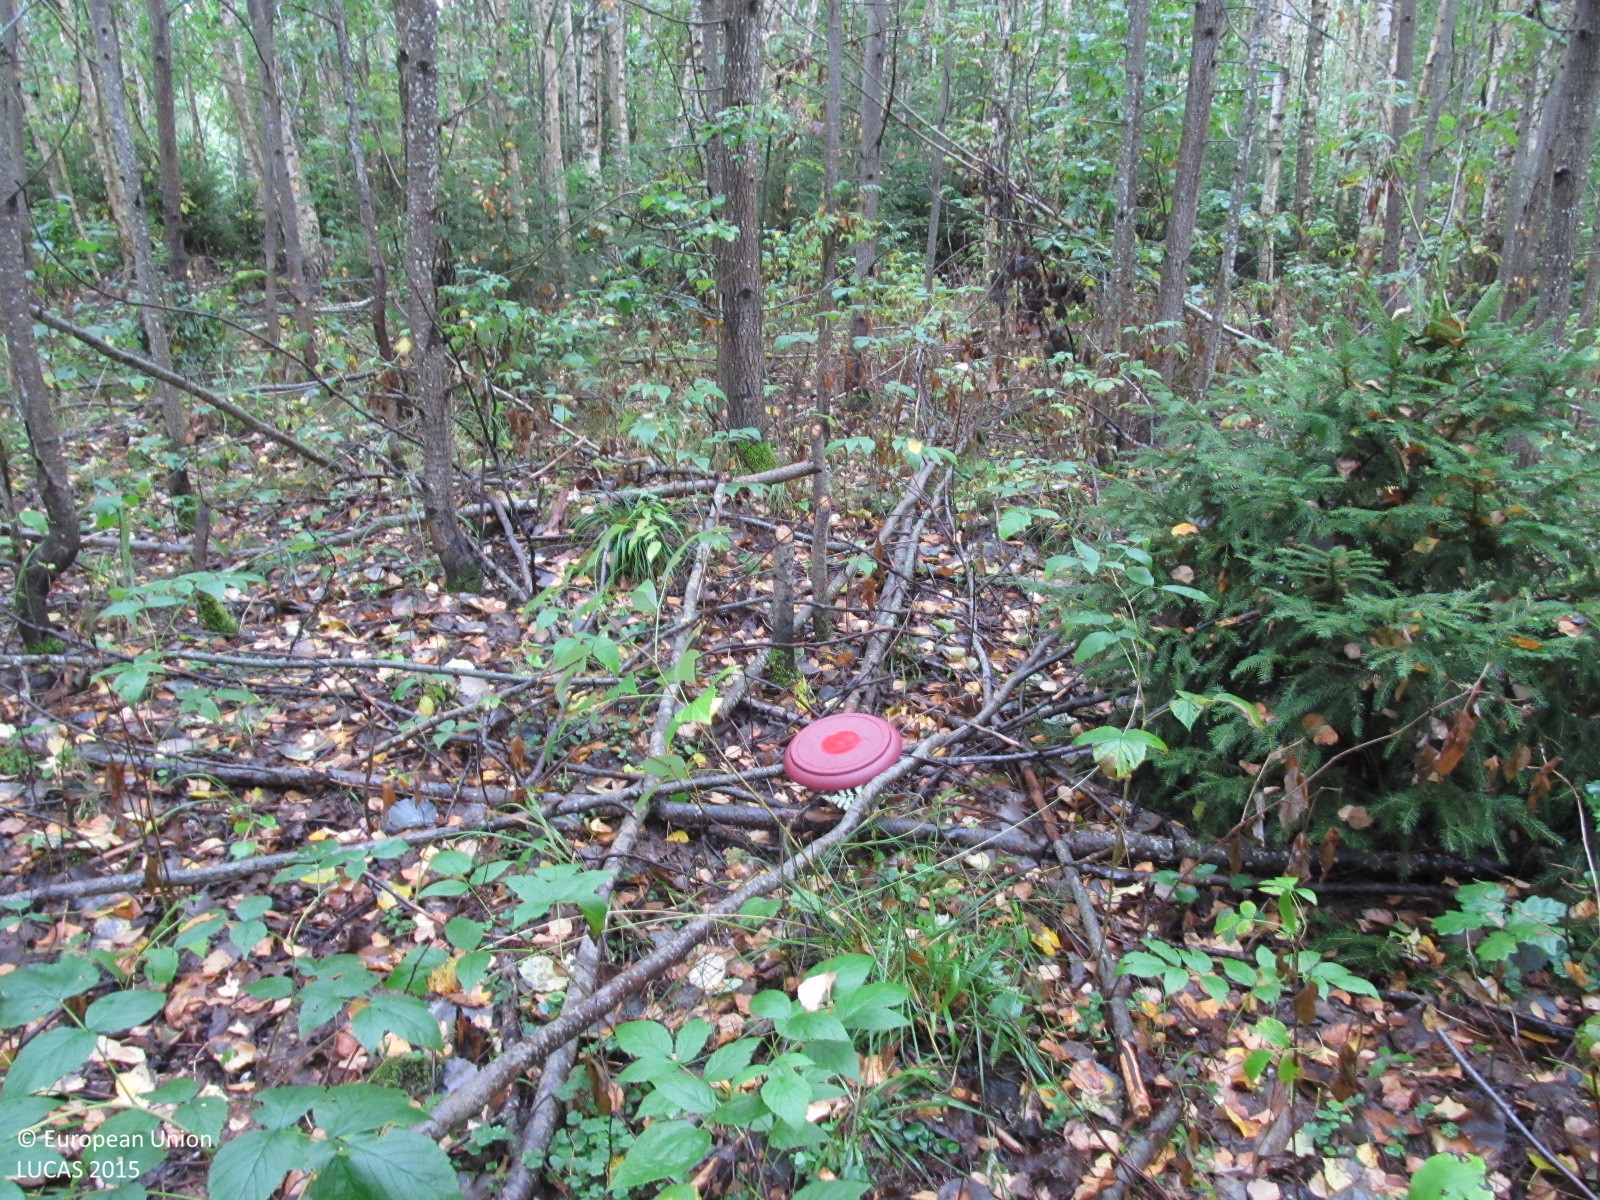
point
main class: Woodland
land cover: Broadleaved woodland
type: non-riverine alder, birch or aspen forest
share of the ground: > 75 %
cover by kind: broadleaved forest trees 75 %, coniferous forest trees 5 %, shrubs 5 %, herbaceous plants 5 %, lichens and mosses 5 %, unconsolidated bare surface 5 %
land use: Forestry
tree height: > 5 m
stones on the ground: < 10 %
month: September
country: LT
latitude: 55.9883
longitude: 22.9062
